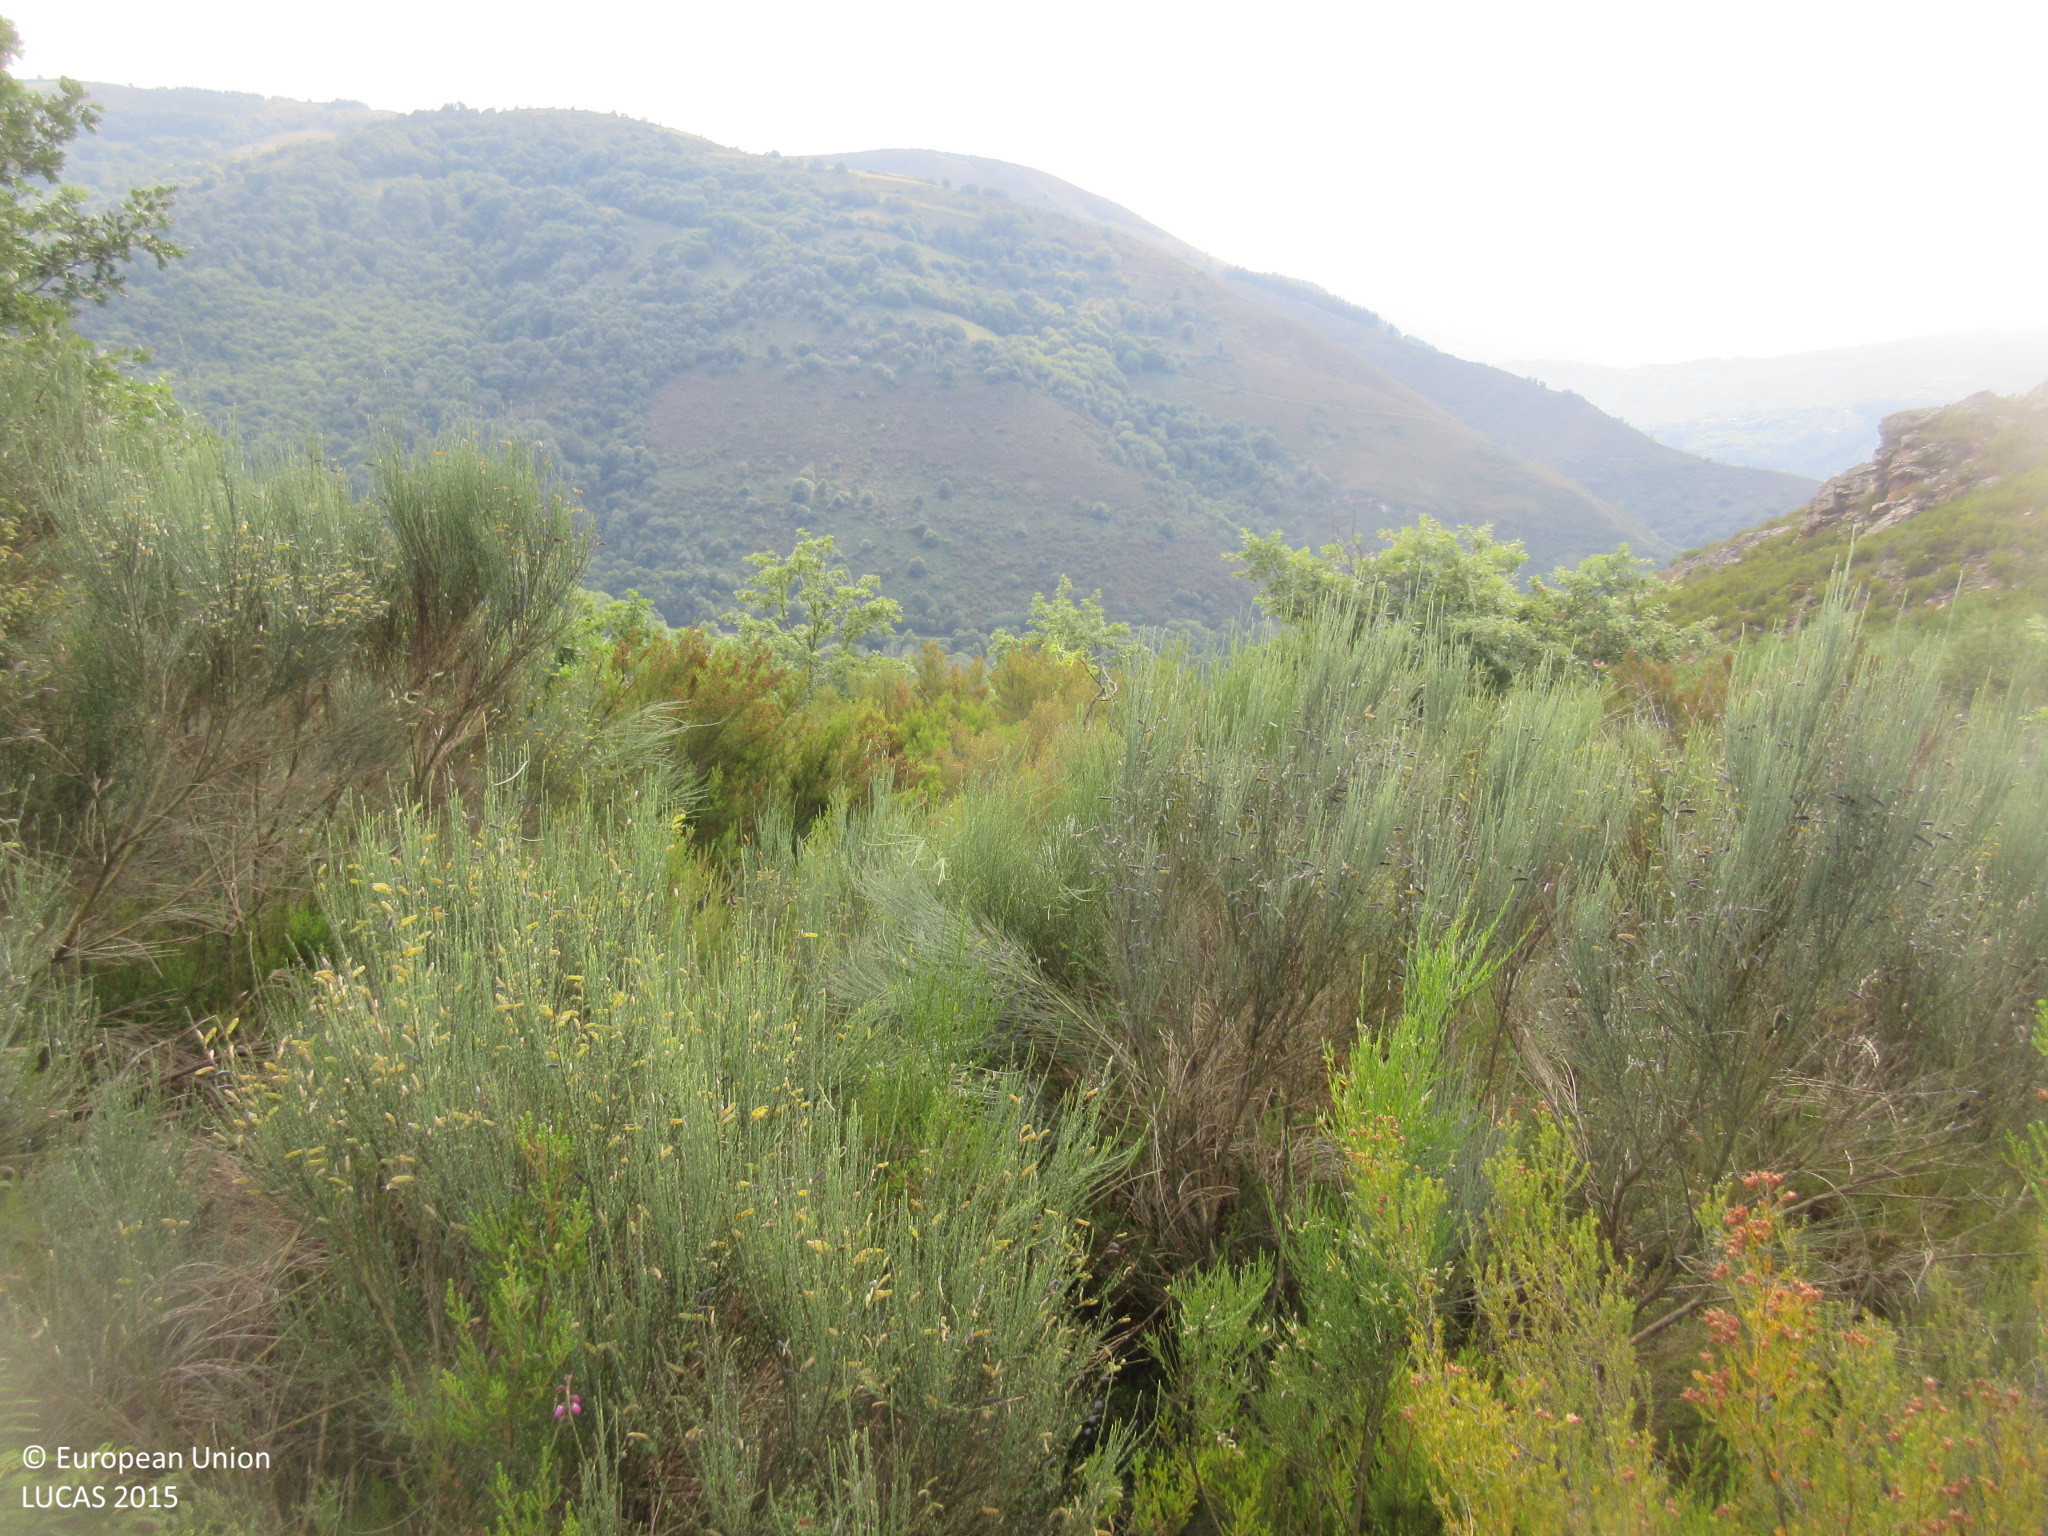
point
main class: Woodland
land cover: Broadleaved woodland
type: acidophilous oak and oak-birch forest
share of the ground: 10 - 25 %
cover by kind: shrubs 80 %, broadleaved forest trees 20 %
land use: Semi-natural and natural areas not in use
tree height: > 5 m
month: June
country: ES
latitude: 42.9595
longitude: -6.9654
